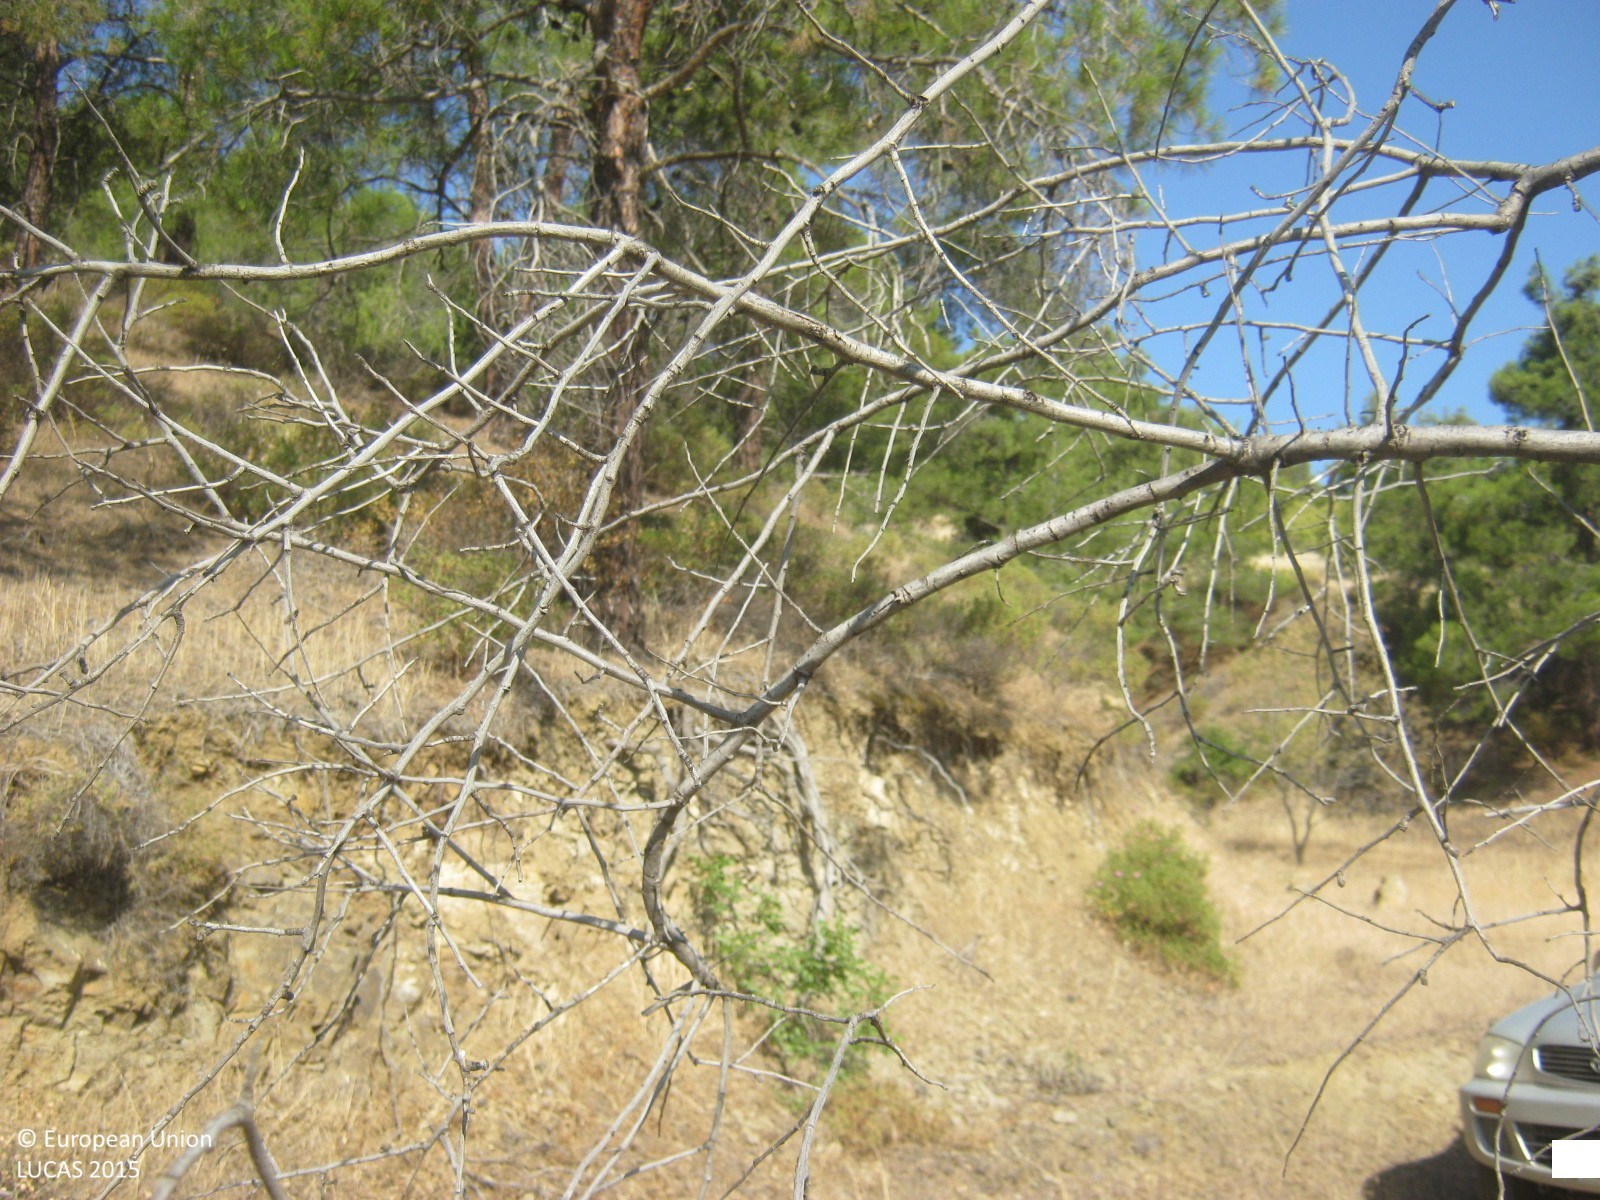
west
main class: Cropland
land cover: Nuts trees
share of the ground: 25 - 50 %
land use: Agriculture (excluding fallow land and kitchen gardens)
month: June
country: CY
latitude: 35.0398
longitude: 32.9183
